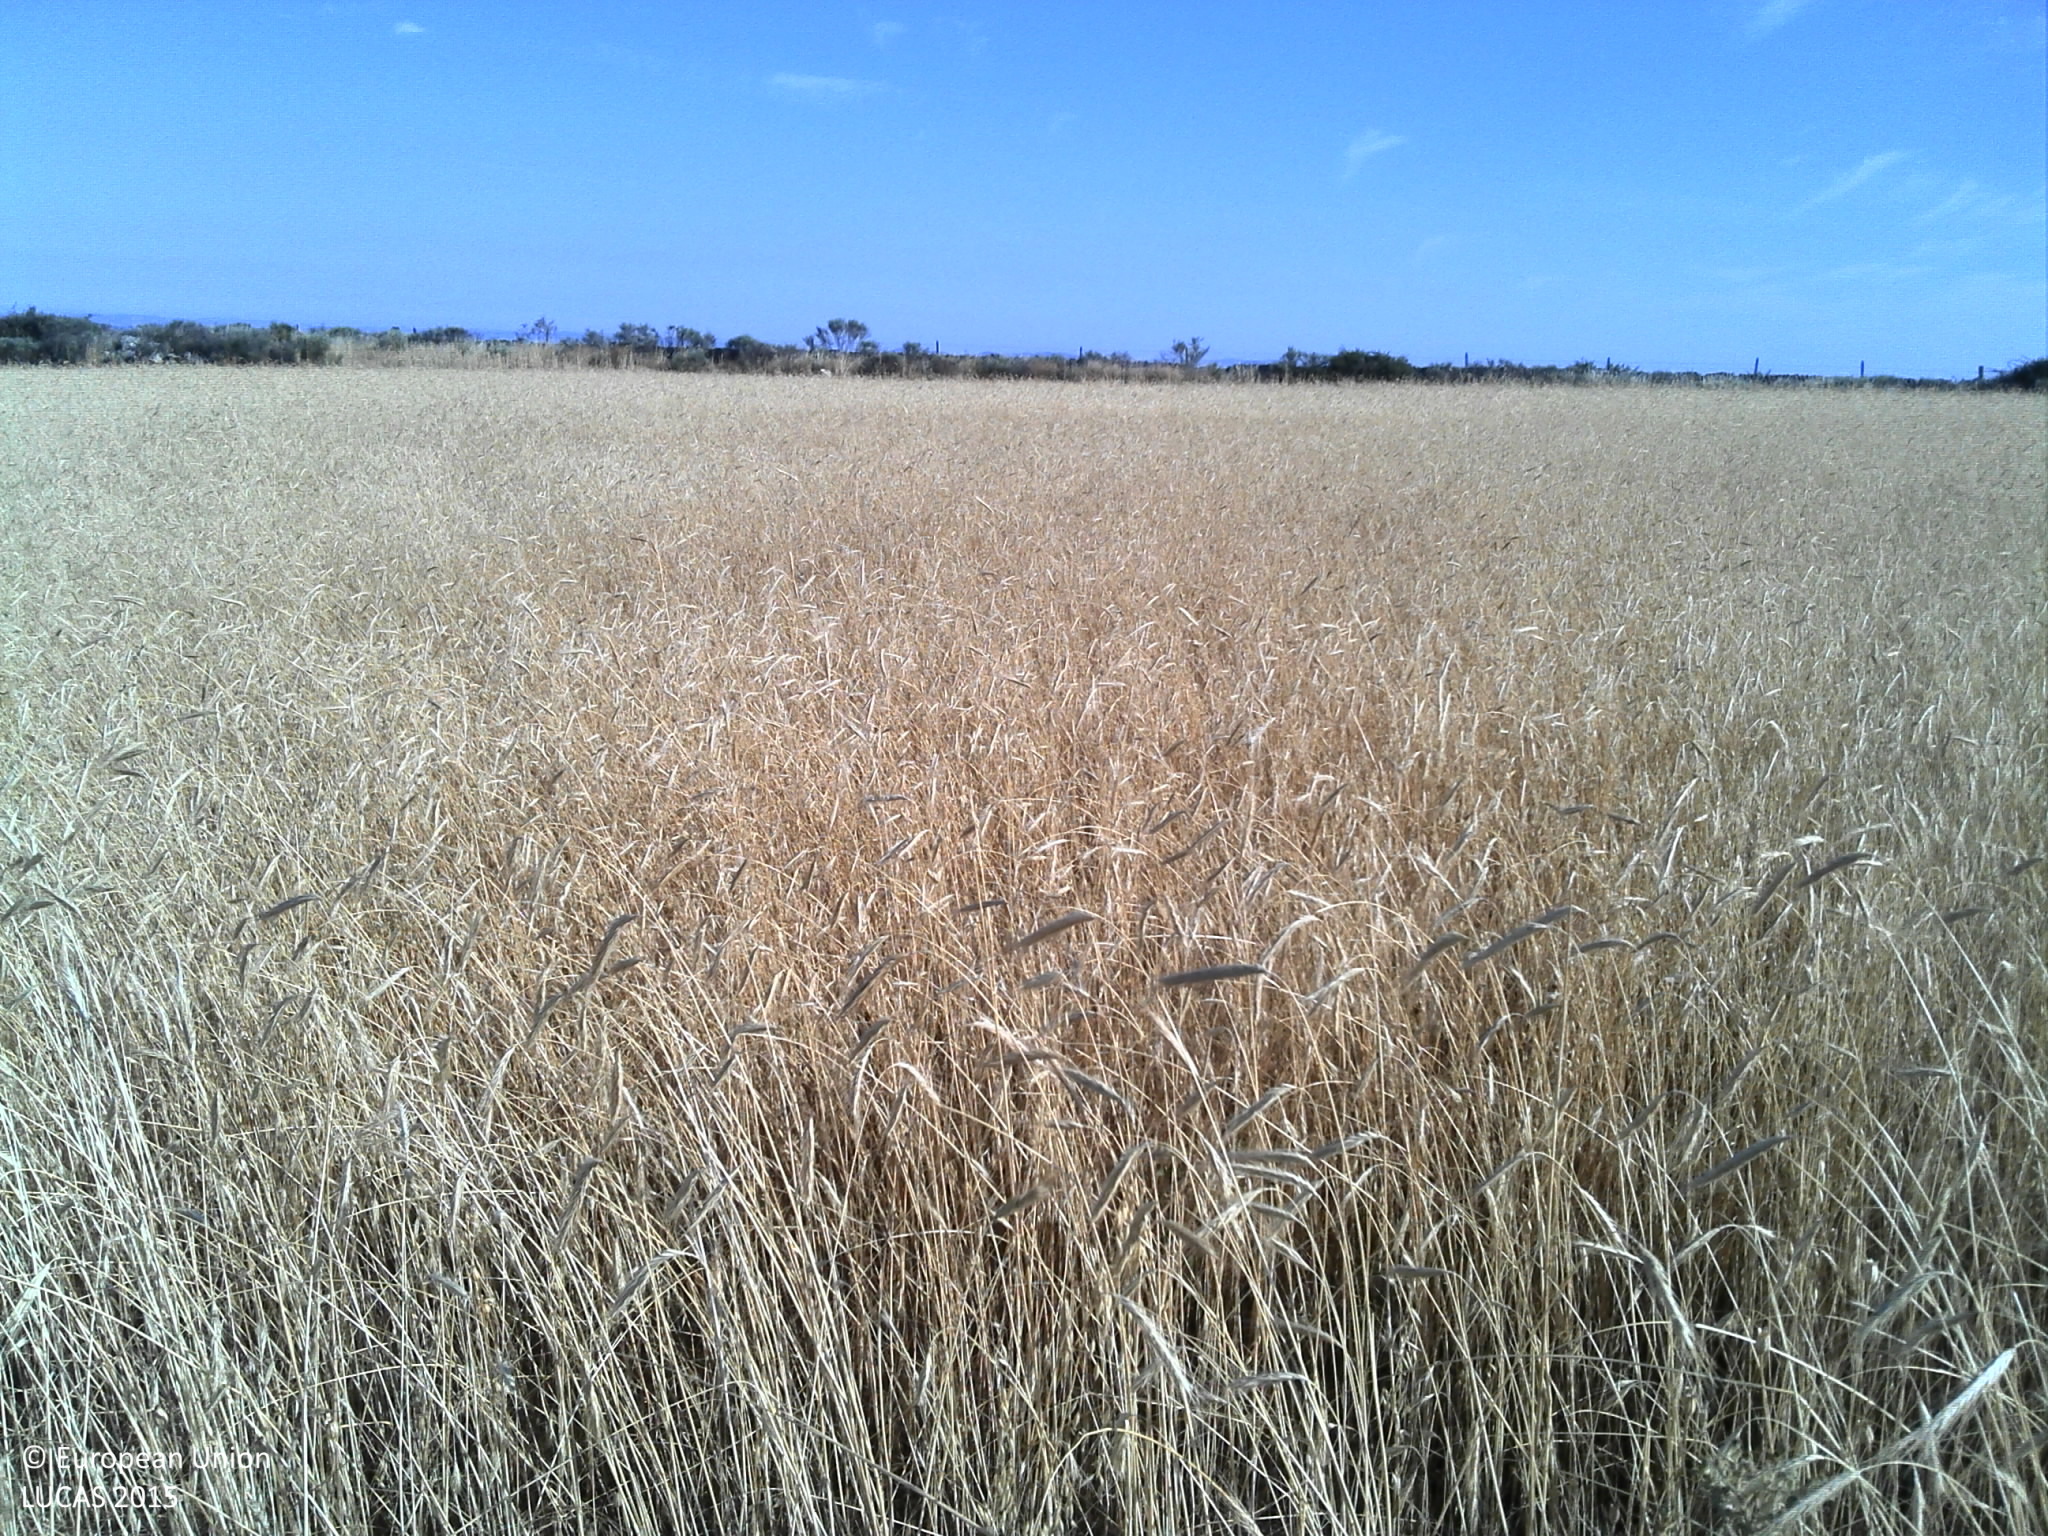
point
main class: Cropland
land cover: Barley
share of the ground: > 75 %
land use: Agriculture (excluding fallow land and kitchen gardens)
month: June
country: PT
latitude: 40.8907
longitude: -6.8972
